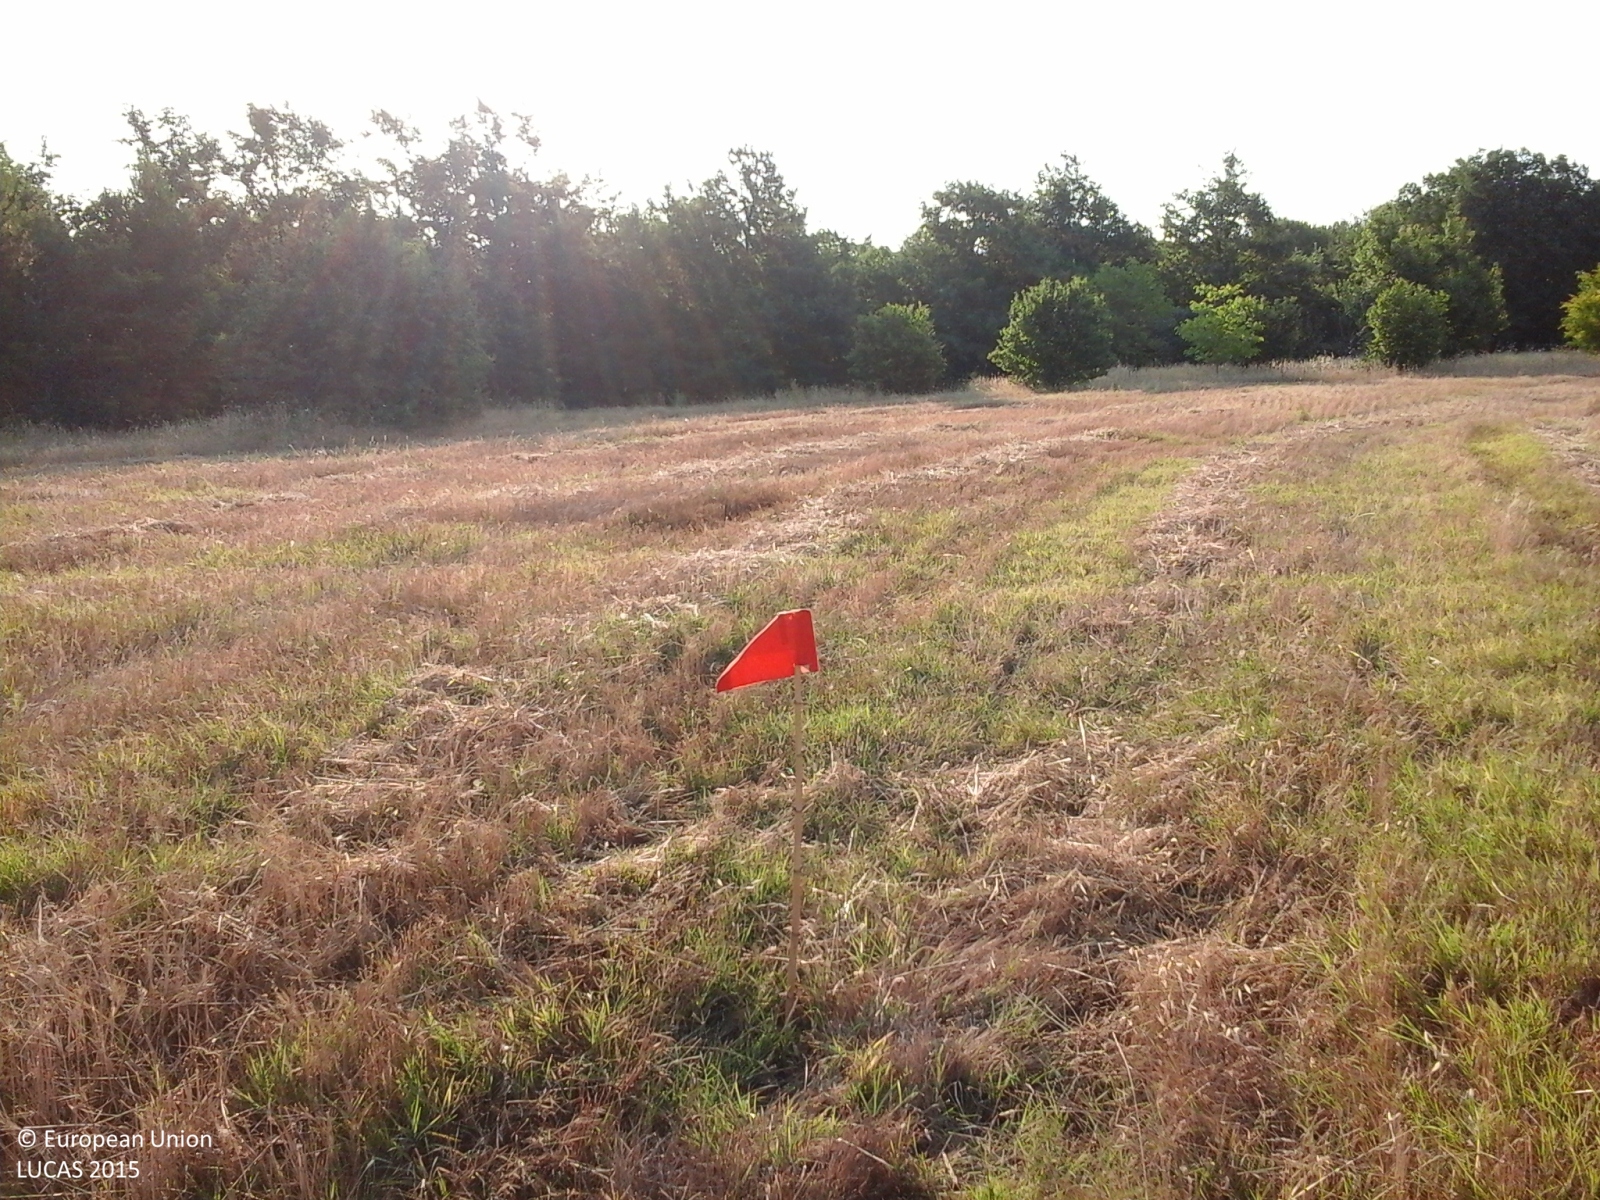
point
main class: Cropland
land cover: Durum wheat
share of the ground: > 75 %
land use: Agriculture (excluding fallow land and kitchen gardens)
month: July
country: IT
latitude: 41.5487
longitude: 14.7190
